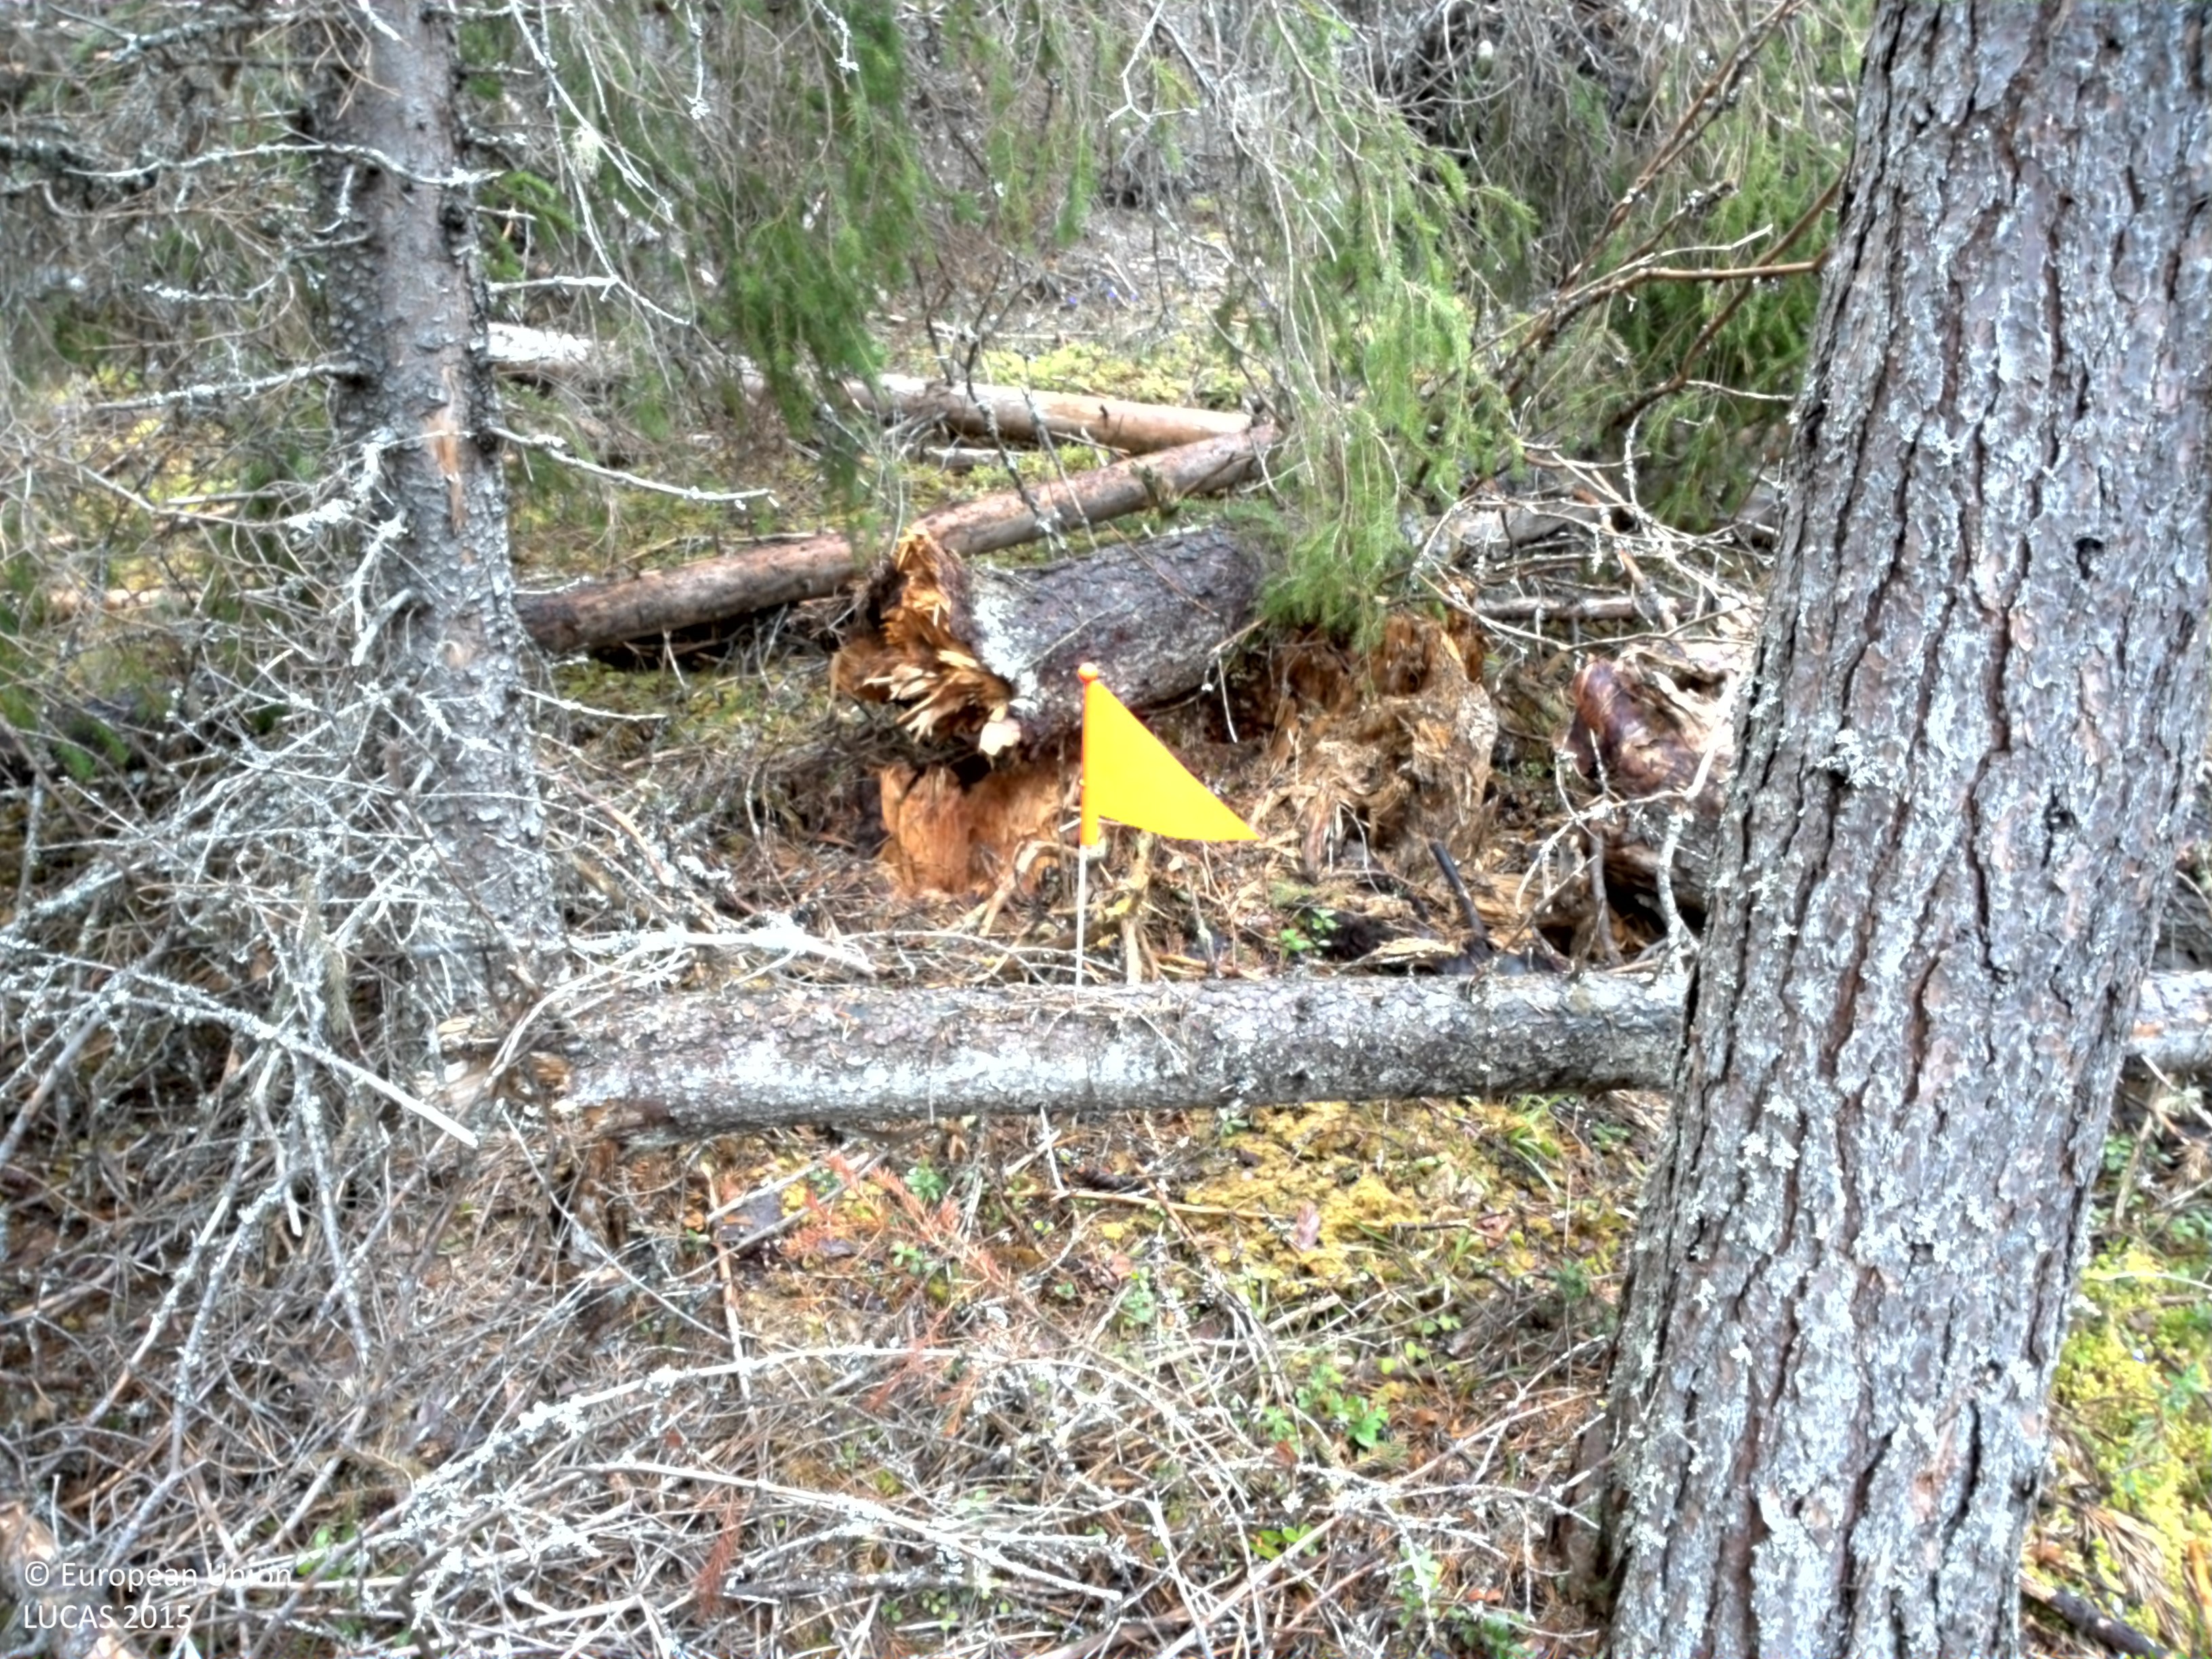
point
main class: Woodland
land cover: Spruce dominated coniferous woodland
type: boreal forest
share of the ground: > 75 %
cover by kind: coniferous forest trees 80 %, lichens and mosses 15 %, broadleaved forest trees 5 %
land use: Forestry
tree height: > 5 m
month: May
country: SE
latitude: 63.3758
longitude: 13.8409
